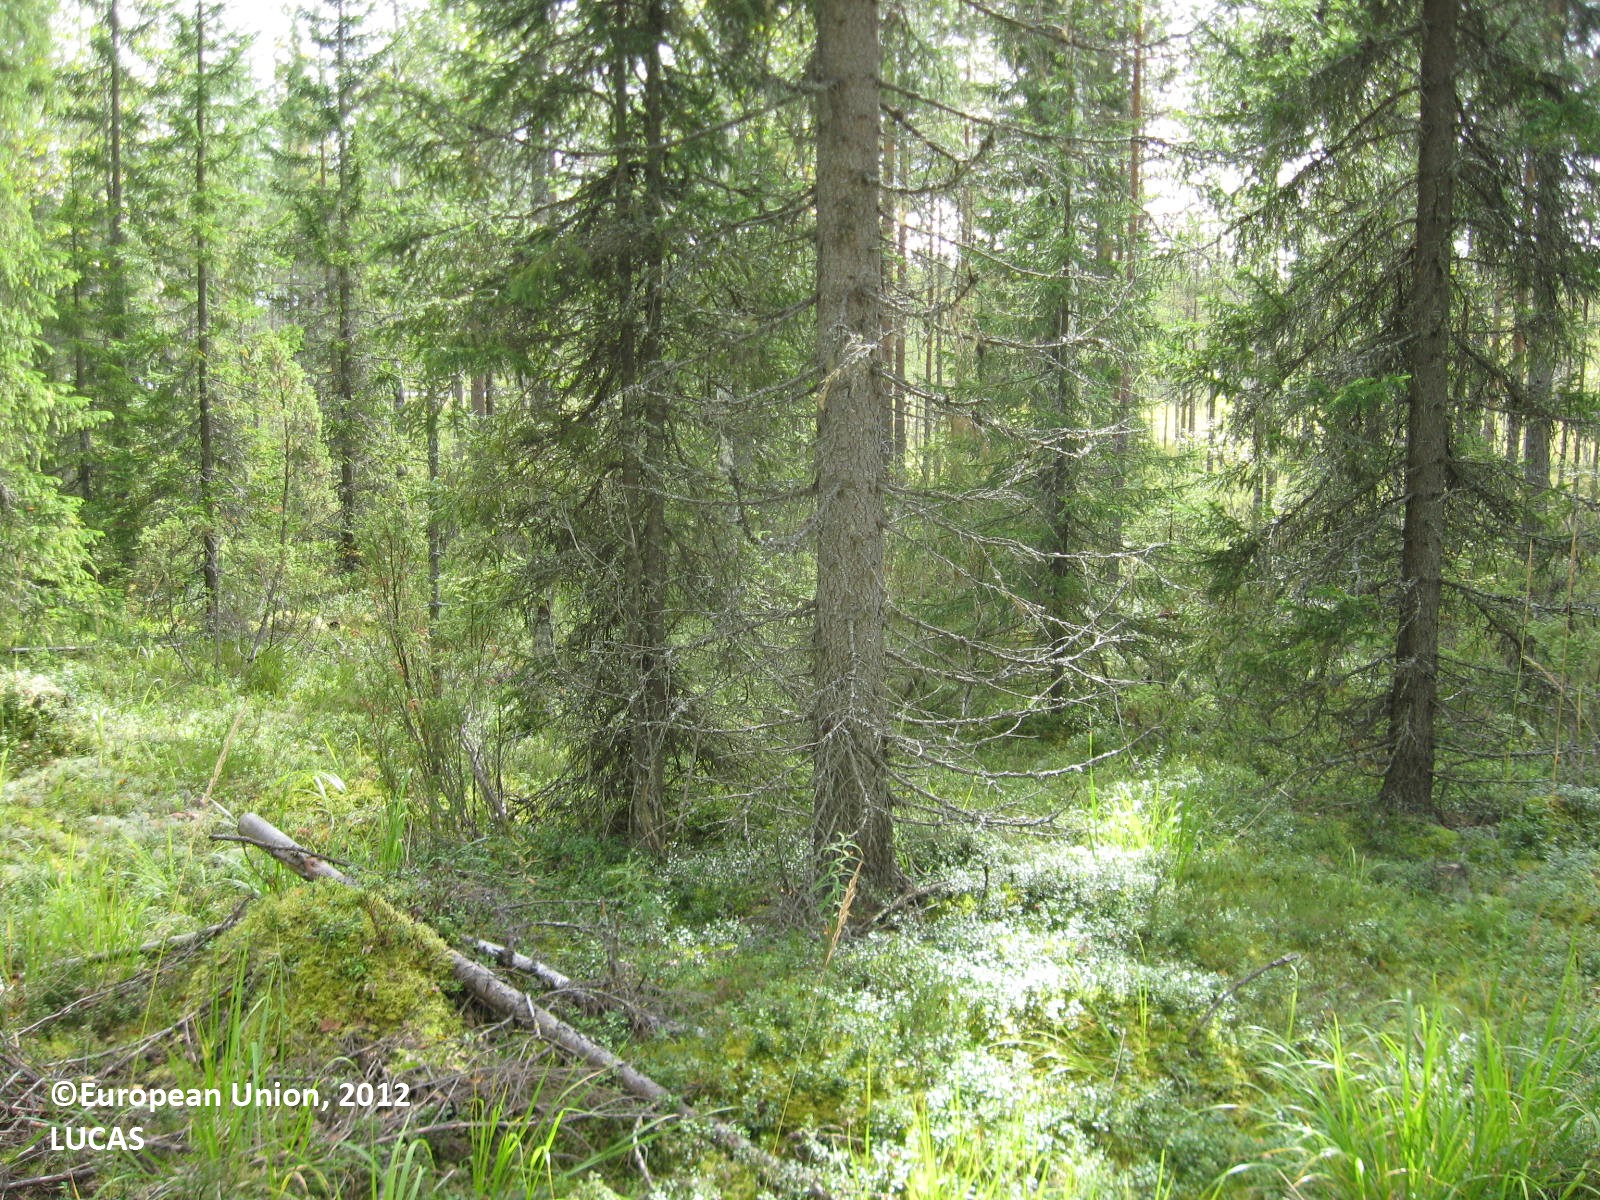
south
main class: Woodland
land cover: Pine dominated coniferous woodland
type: boreal forest
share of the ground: 50 - 75 %
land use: Forestry
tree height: > 5 m
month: August
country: FI
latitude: 63.7762
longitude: 29.1339
